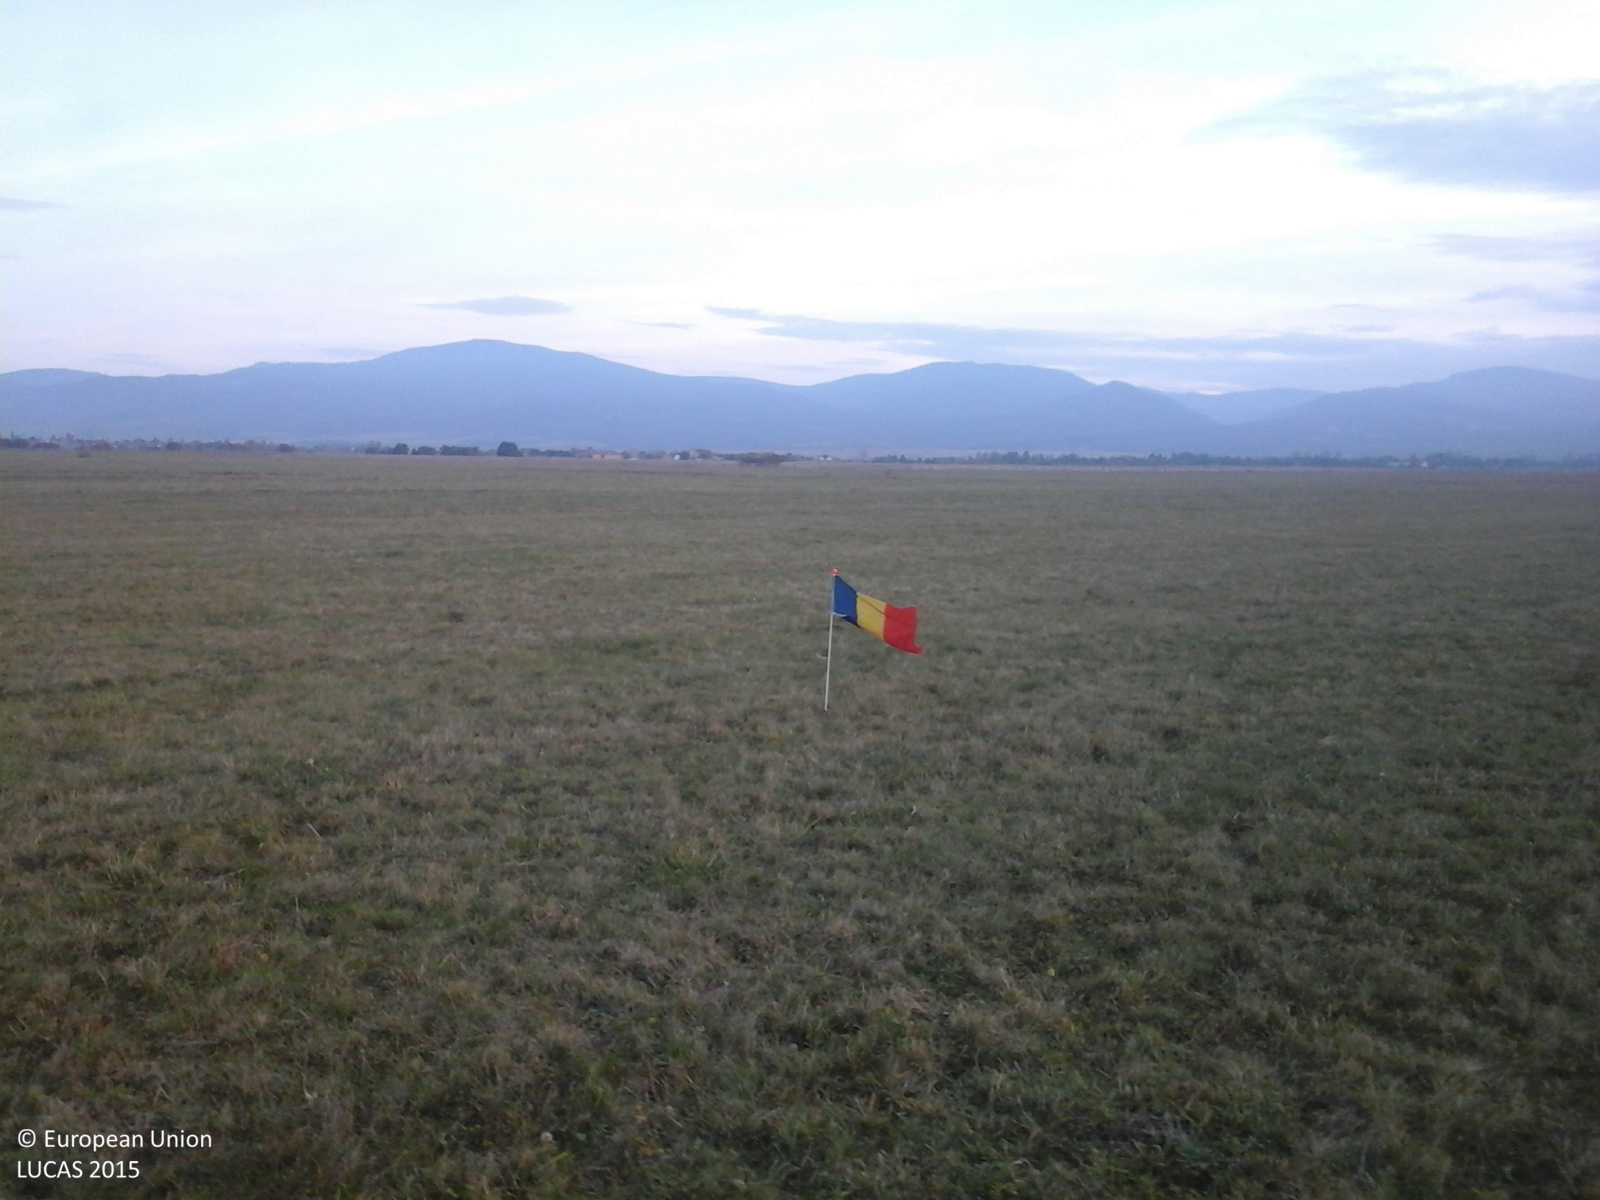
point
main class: Grassland
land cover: Grassland without tree/shrub cover
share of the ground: > 75 %
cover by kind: herbaceous plants 100 %
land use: Agriculture (excluding fallow land and kitchen gardens)
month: October
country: RO
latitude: 46.7079
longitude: 25.4255
